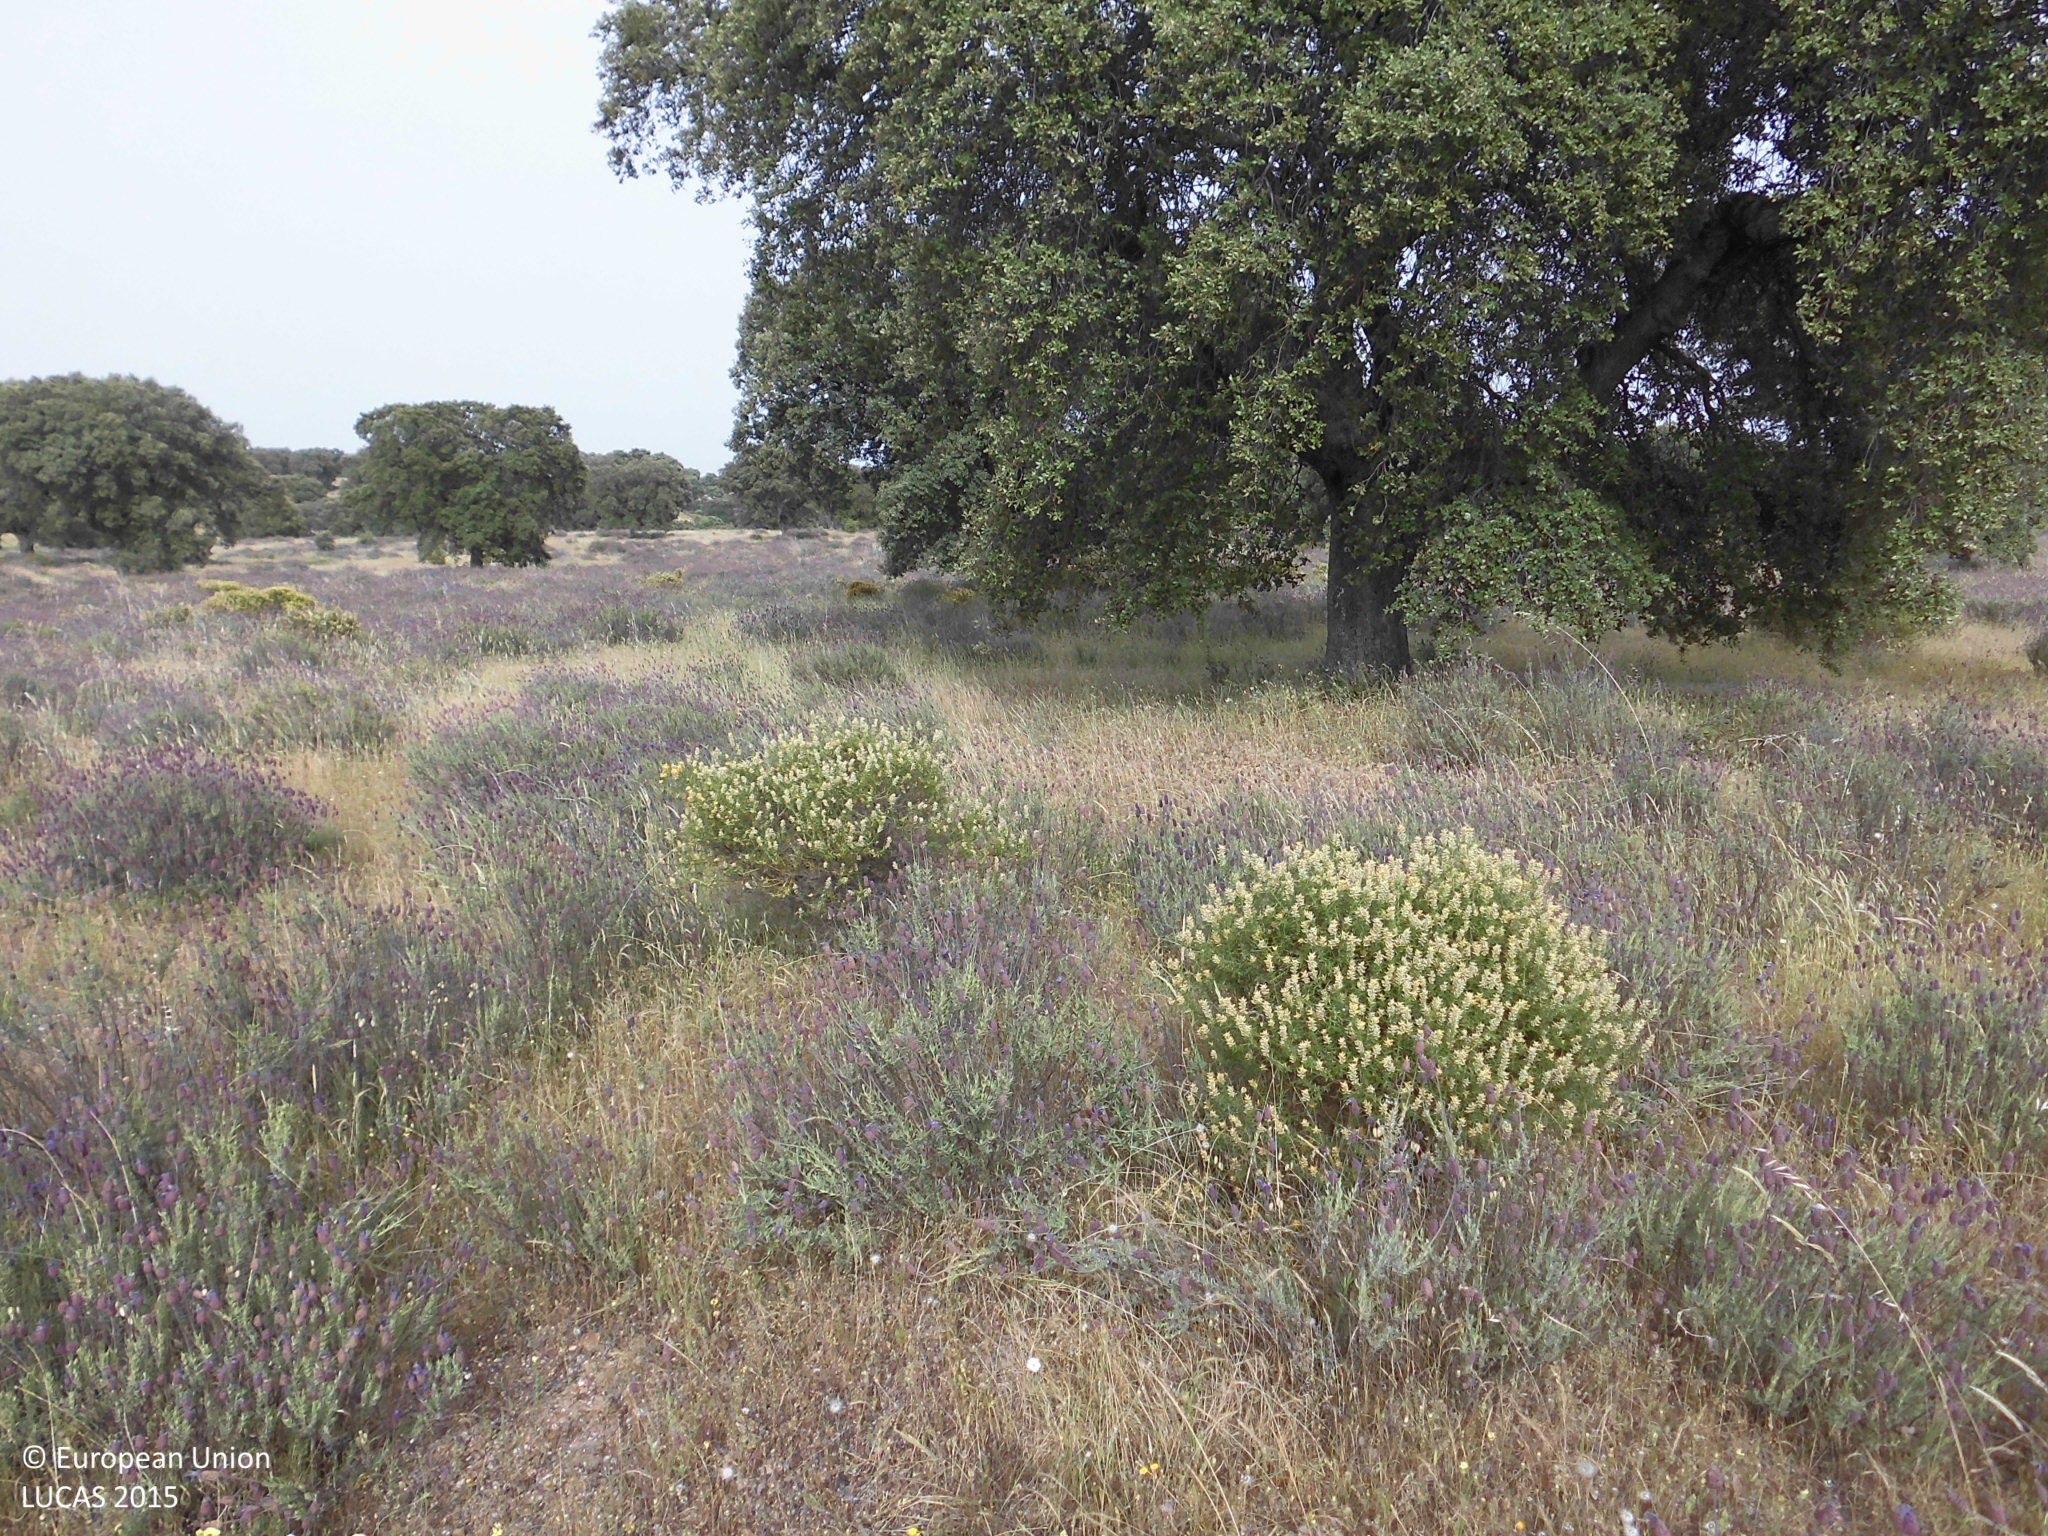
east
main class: Woodland
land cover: Broadleaved woodland
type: broadleaved evergreen forest
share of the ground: 25 - 50 %
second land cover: Grassland without tree/shrub cover
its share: > 75 %
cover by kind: herbaceous plants 55 %, broadleaved forest trees 30 %, shrubs 15 %
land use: Forestry
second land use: Agriculture (excluding fallow land and kitchen gardens)
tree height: > 5 m
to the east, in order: Broadleaved woodland; Grassland without tree/shrub cover
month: May
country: ES
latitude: 39.6575
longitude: -6.1390
